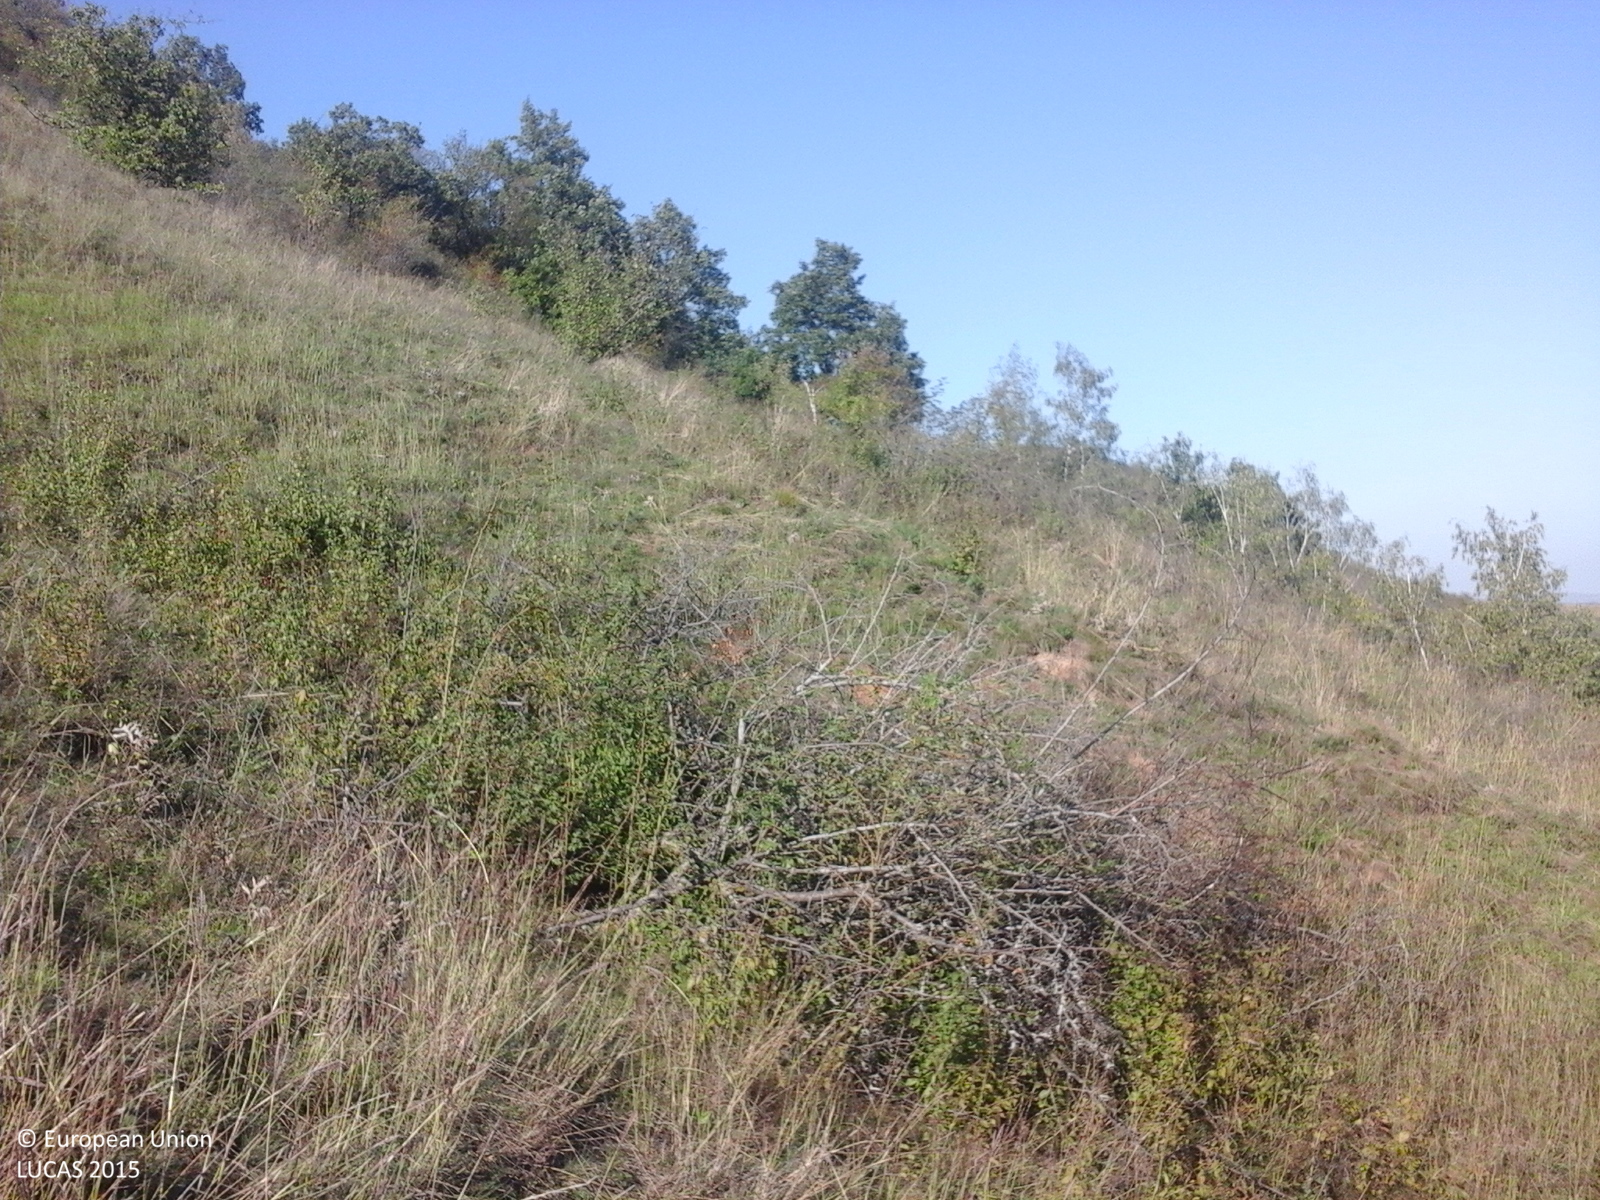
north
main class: Grassland
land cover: Grassland with sparse tree/shrub cover
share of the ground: > 75 %
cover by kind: herbaceous plants 85 %, shrubs 10 %, broadleaved forest trees 5 %
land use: Fallow land
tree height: < 5 m
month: October
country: RO
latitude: 46.5343
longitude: 23.6169
